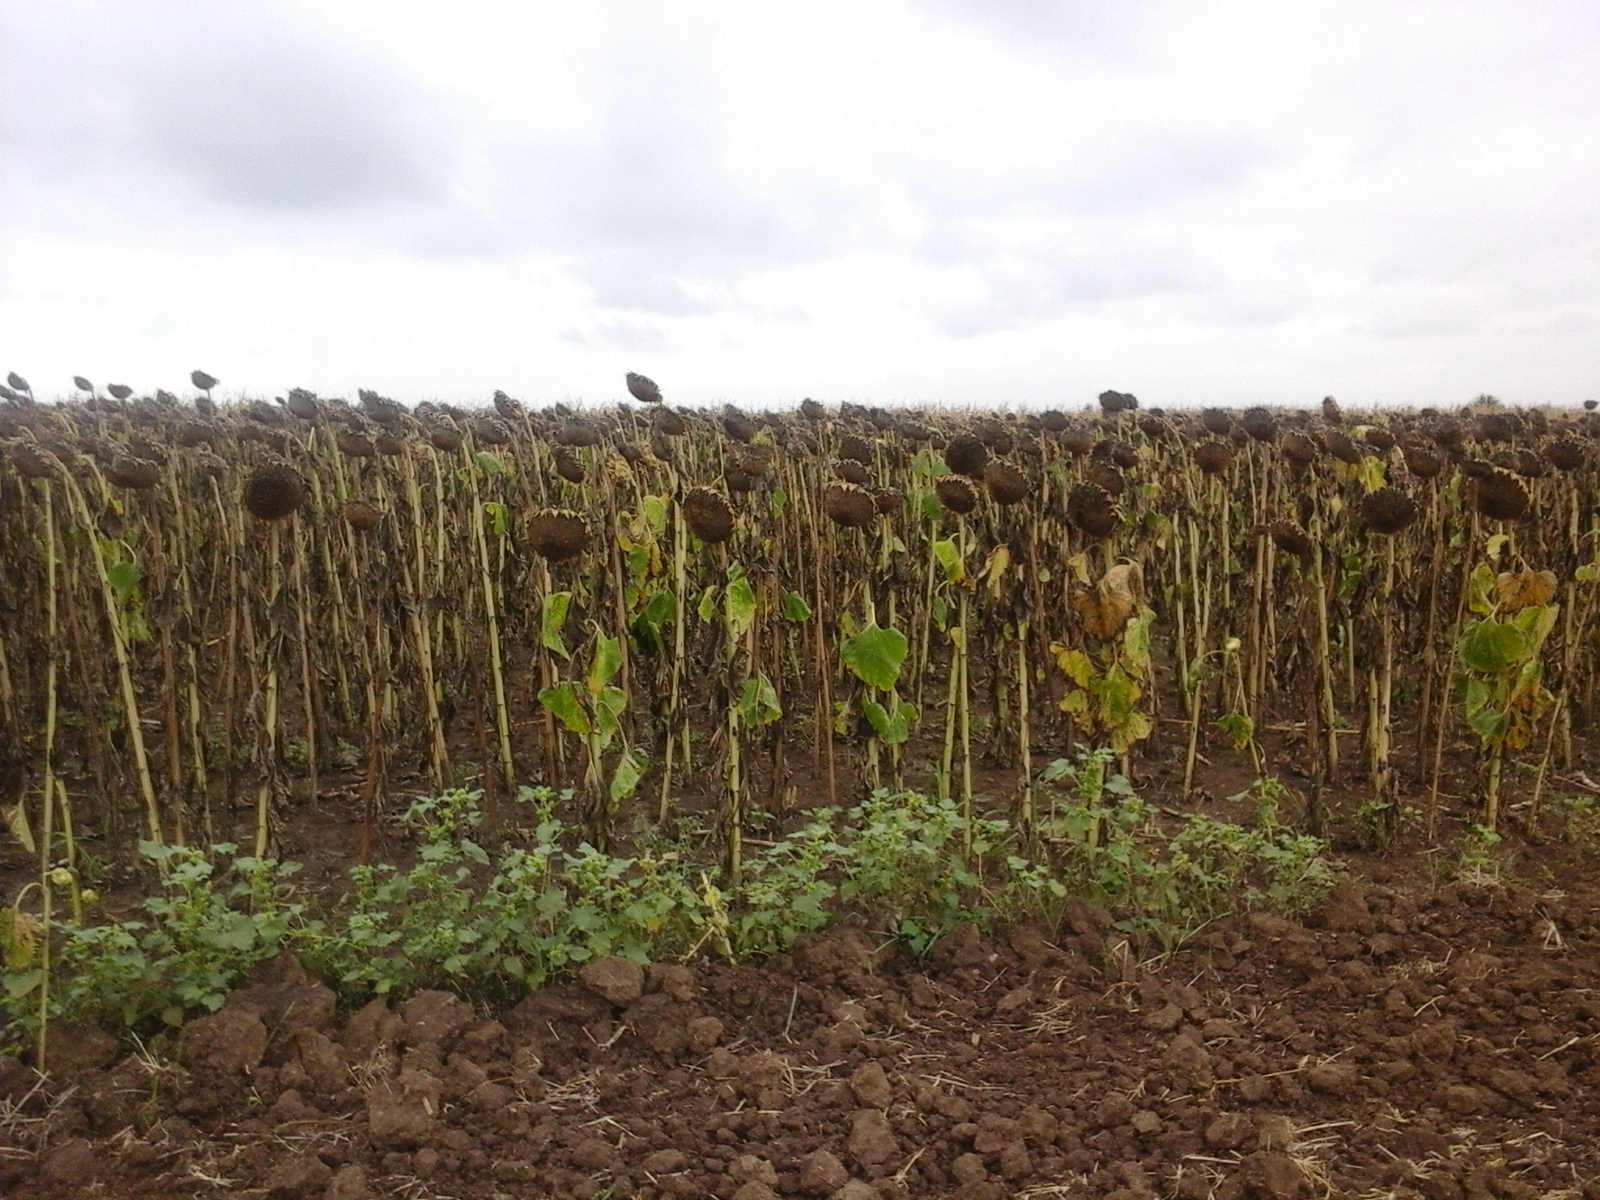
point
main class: Cropland
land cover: Sunflower
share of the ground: > 75 %
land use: Agriculture (excluding fallow land and kitchen gardens)
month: September
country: RO
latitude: 47.2108
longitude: 21.9165
